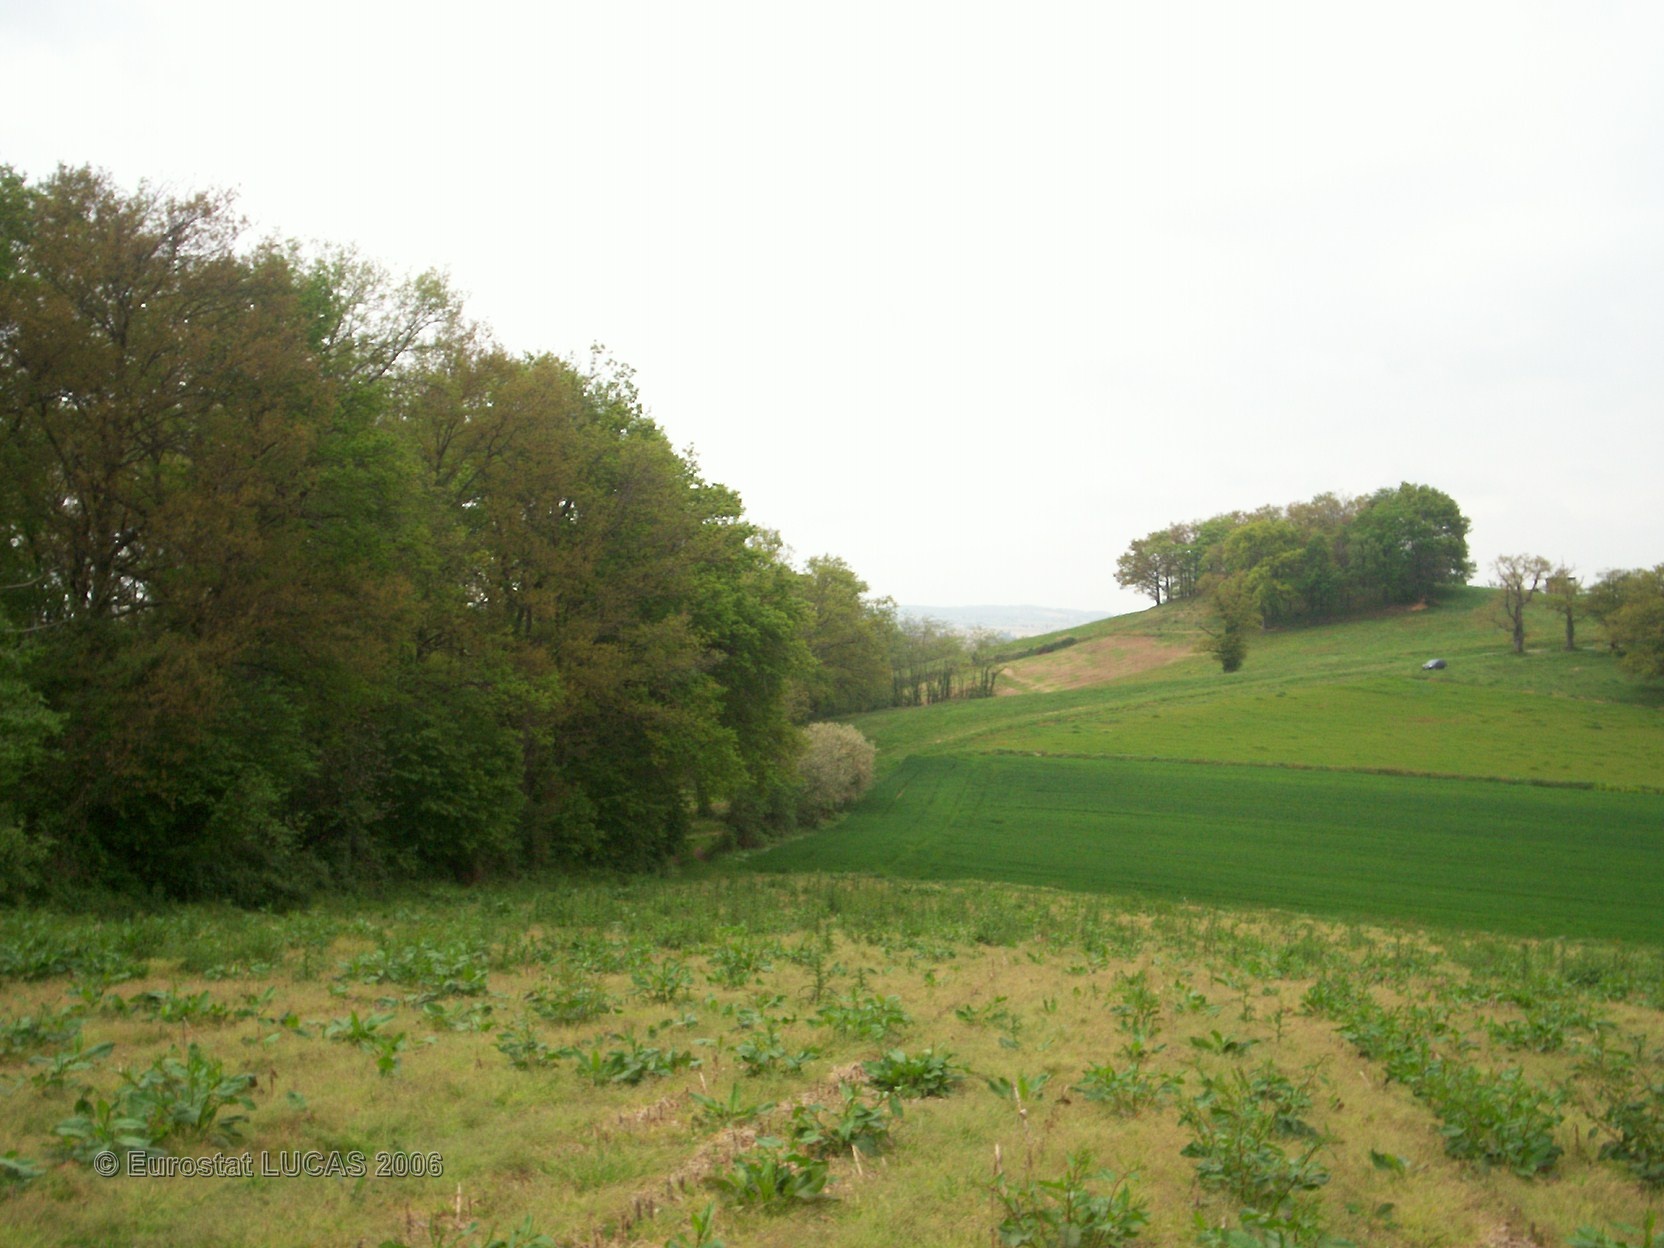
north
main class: Grassland
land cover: Grassland without tree/shrub cover
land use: Agriculture (excluding fallow land and kitchen gardens)
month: April
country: FR
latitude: 43.2622
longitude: 0.3279
